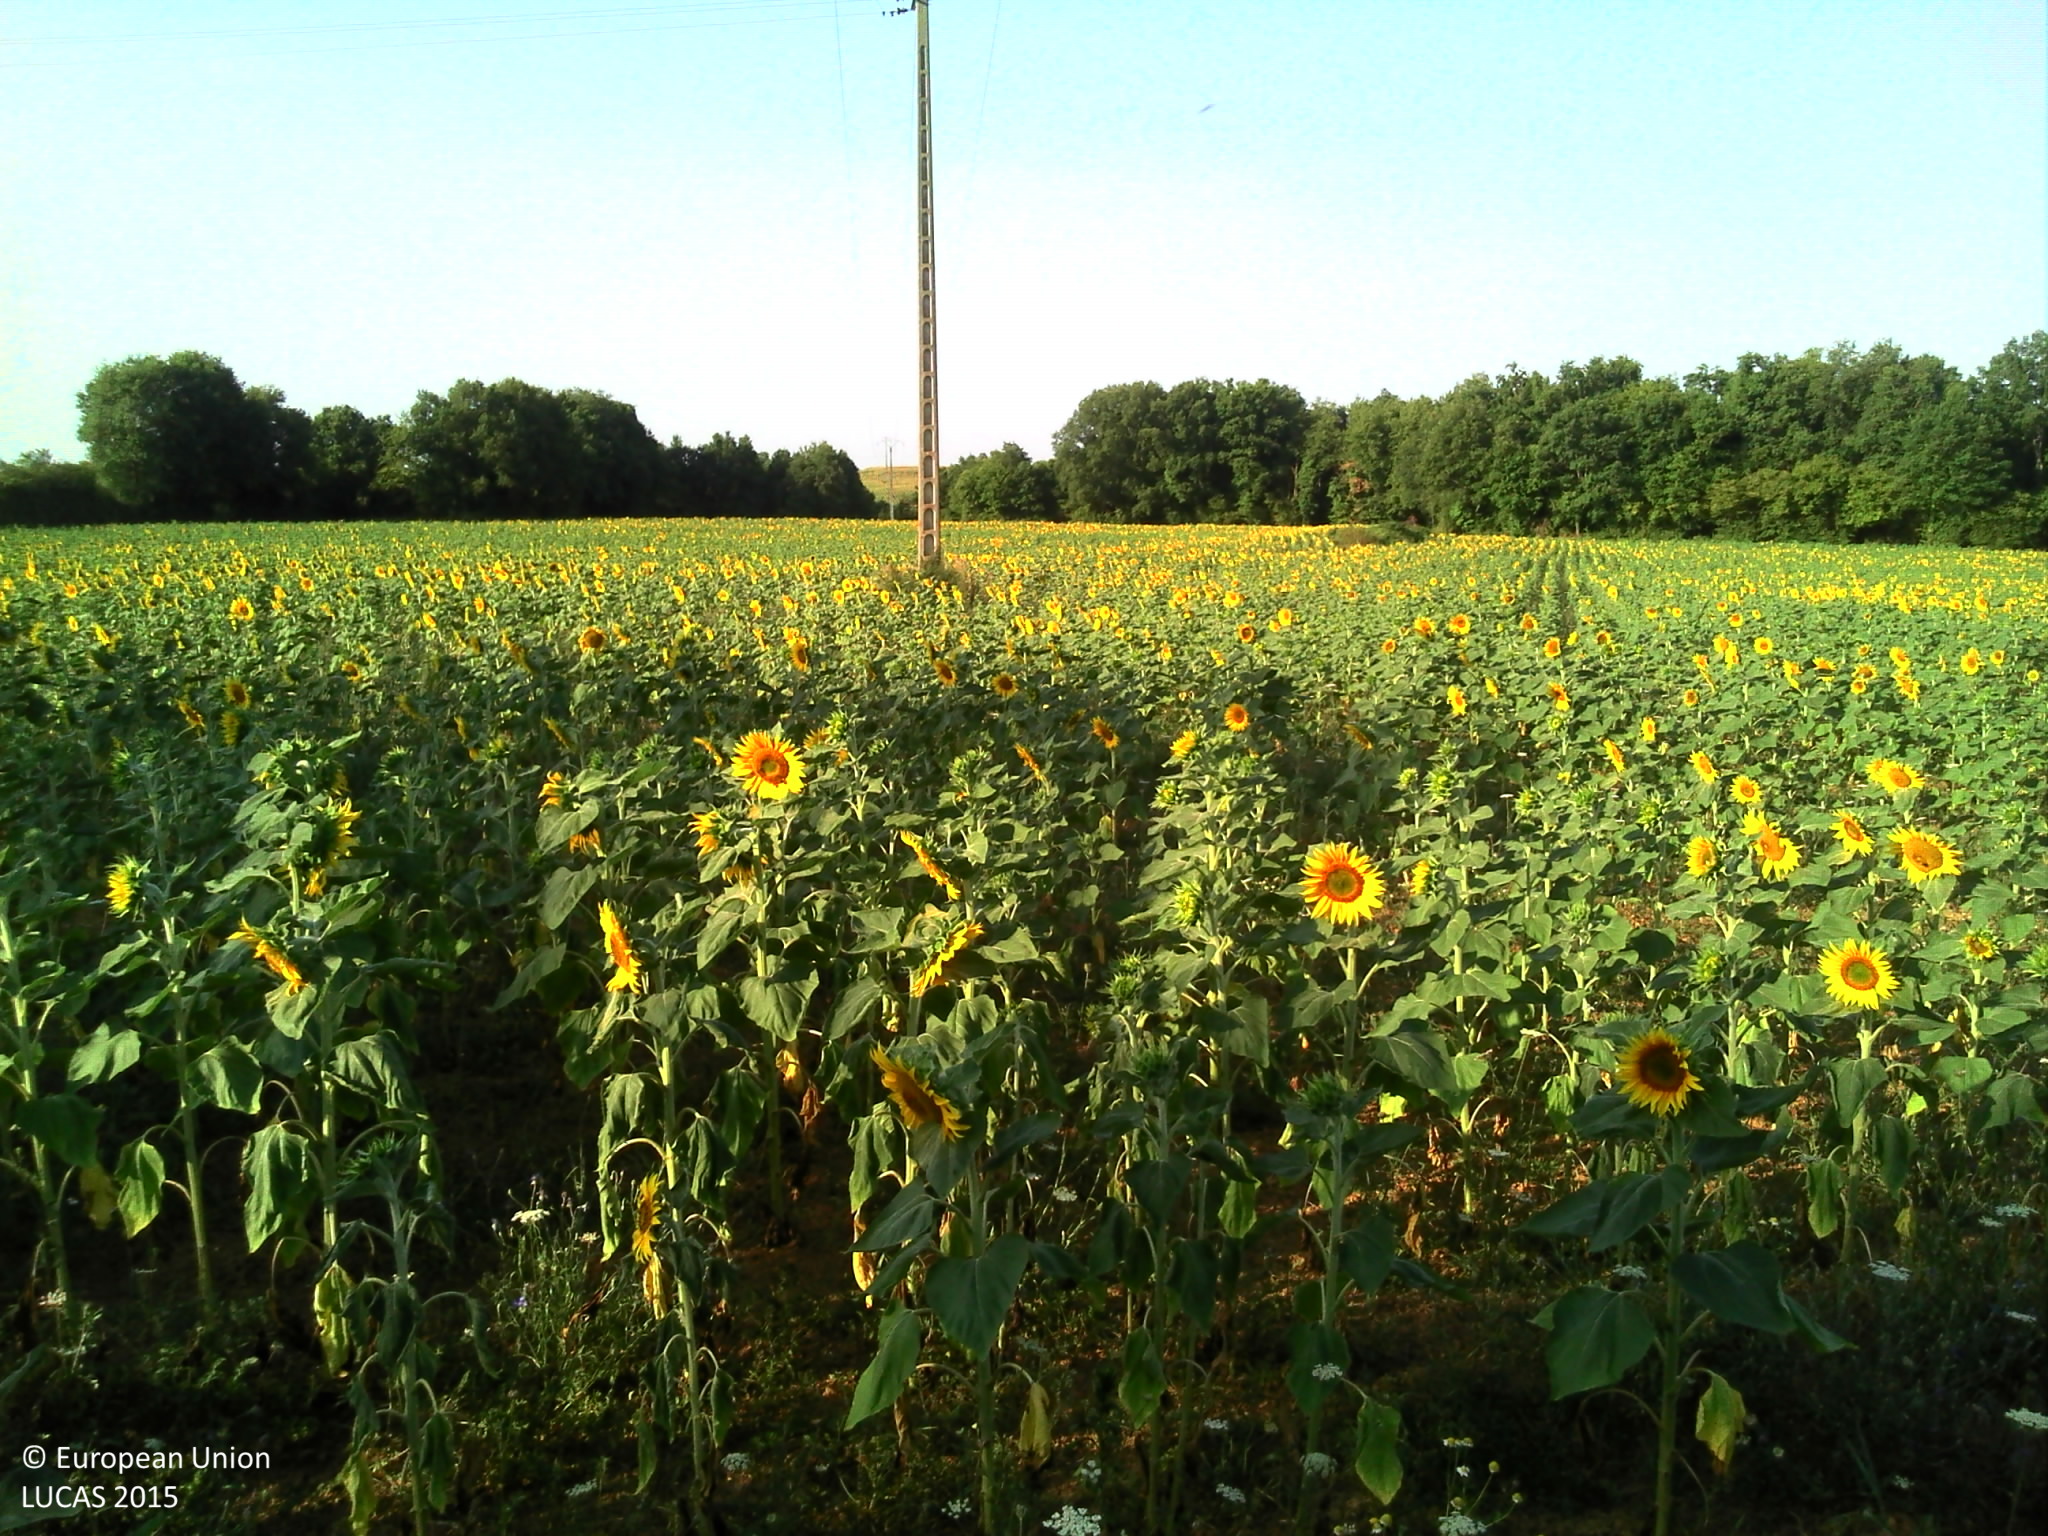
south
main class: Cropland
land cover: Sunflower
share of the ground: > 75 %
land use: Agriculture (excluding fallow land and kitchen gardens)
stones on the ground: < 10 %
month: July
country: FR
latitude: 46.3033
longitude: 0.6494
